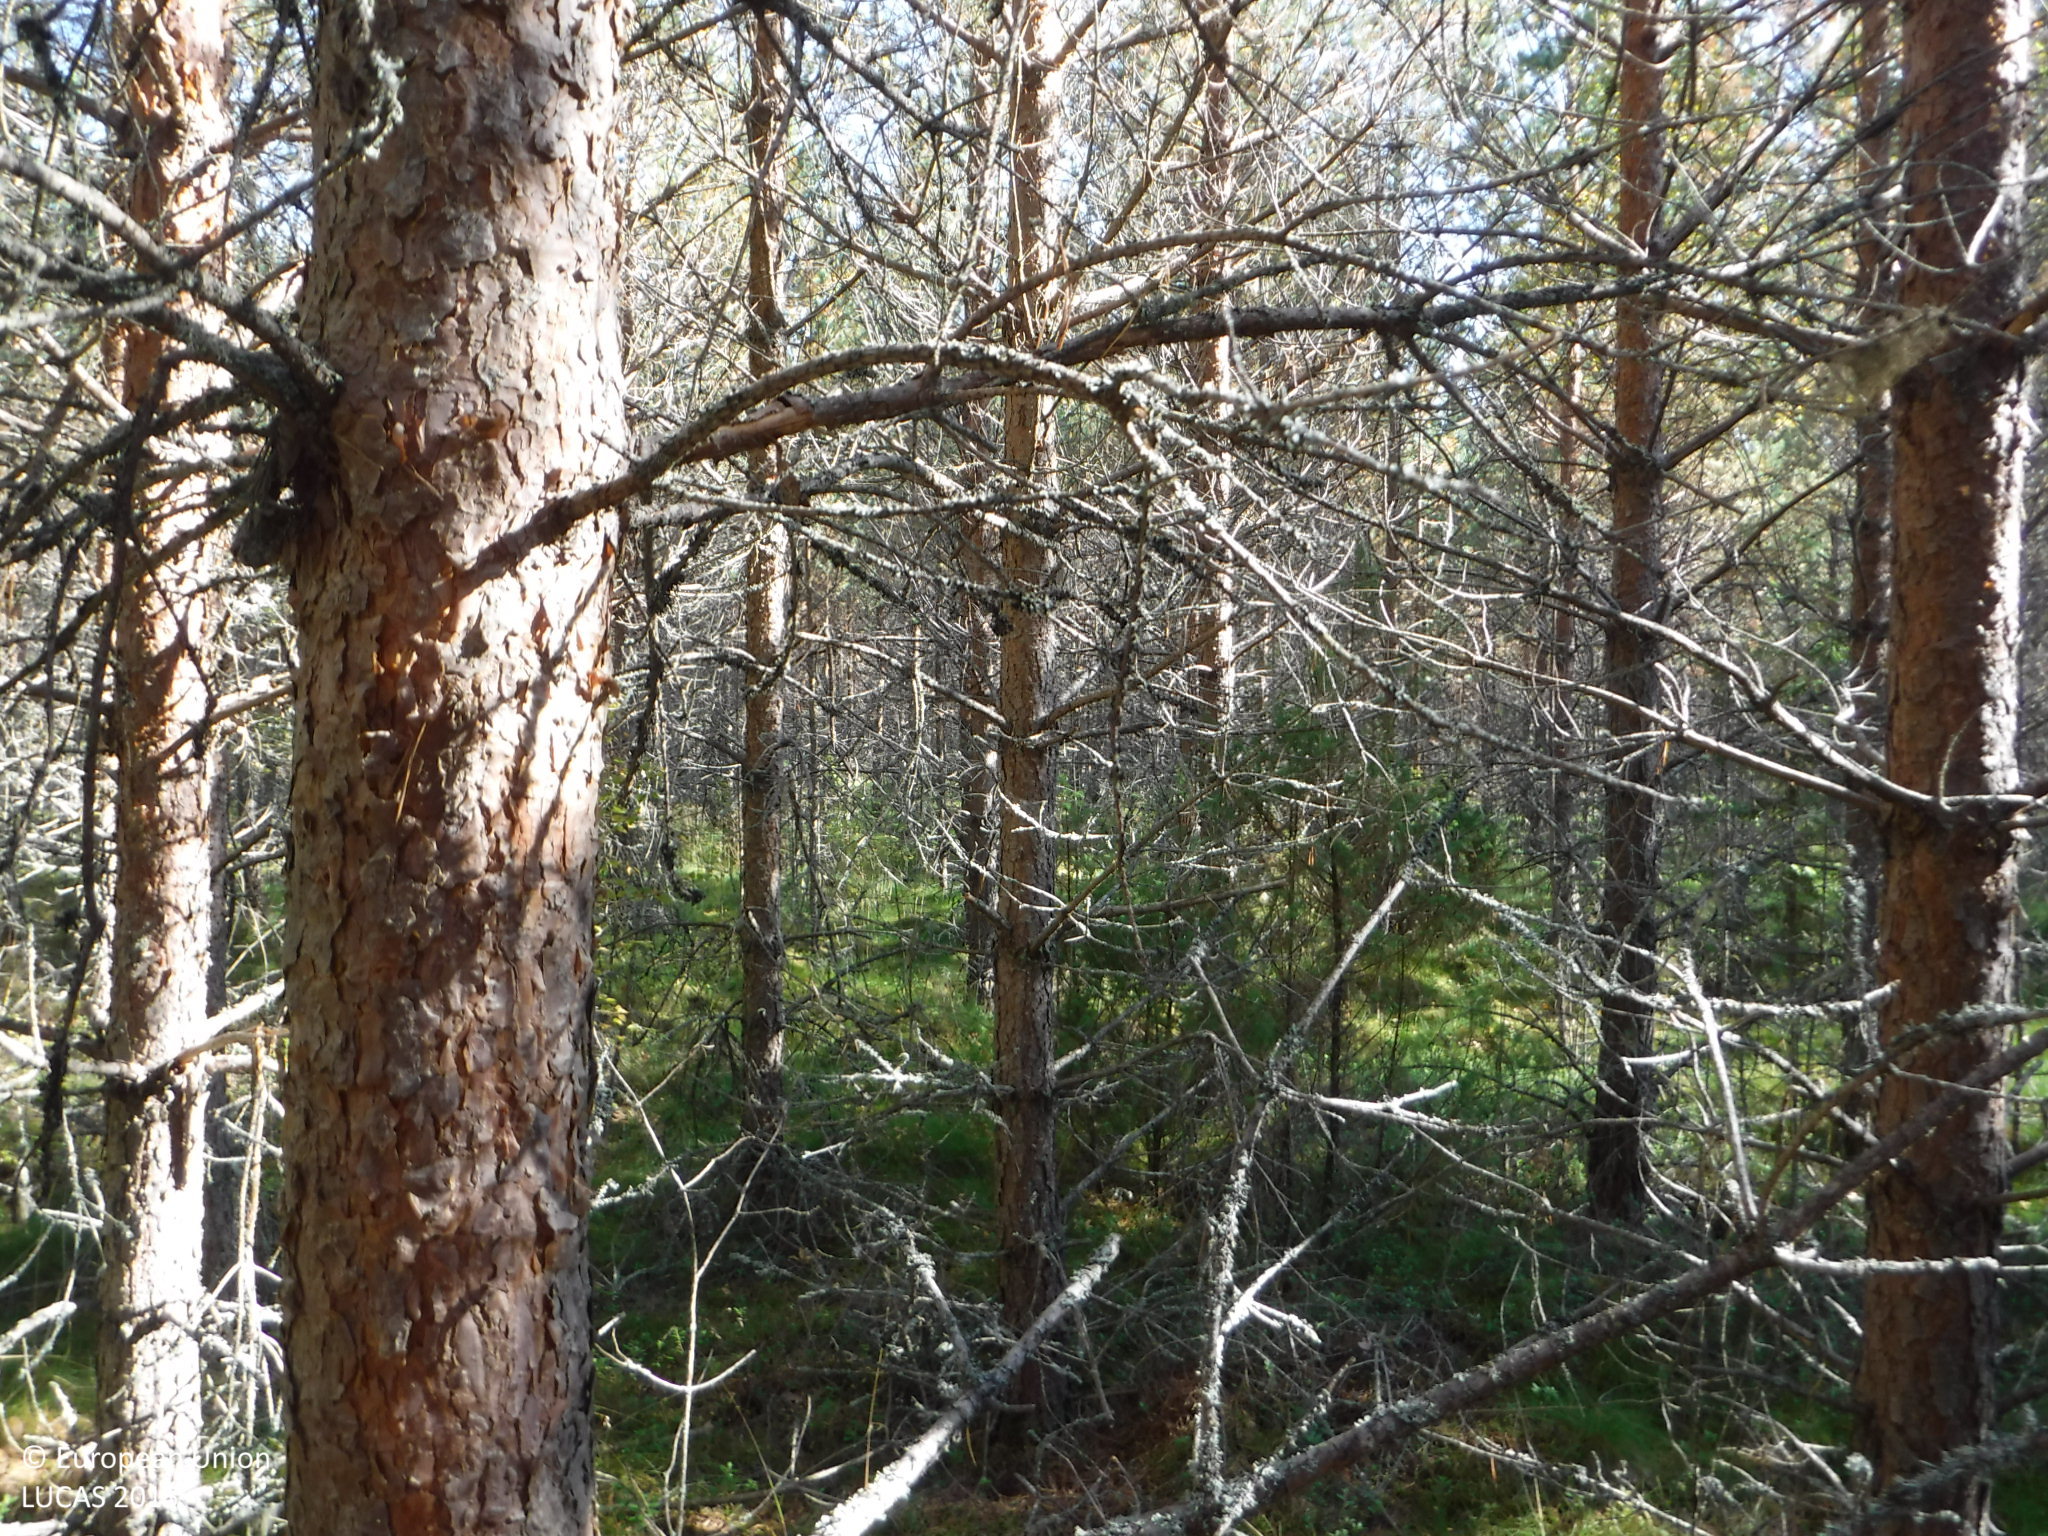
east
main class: Woodland
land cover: Pine dominated coniferous woodland
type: boreal forest
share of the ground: > 75 %
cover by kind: coniferous forest trees 75 %, herbaceous plants 25 %
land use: Forestry
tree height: > 5 m
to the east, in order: Pine dominated coniferous woodland; Paved roads, cycling and walking lanes; Sand; Pine dominated coniferous woodland; Tracks; Pine dominated coniferous woodland
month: September
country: FI
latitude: 61.7687
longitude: 22.8197
